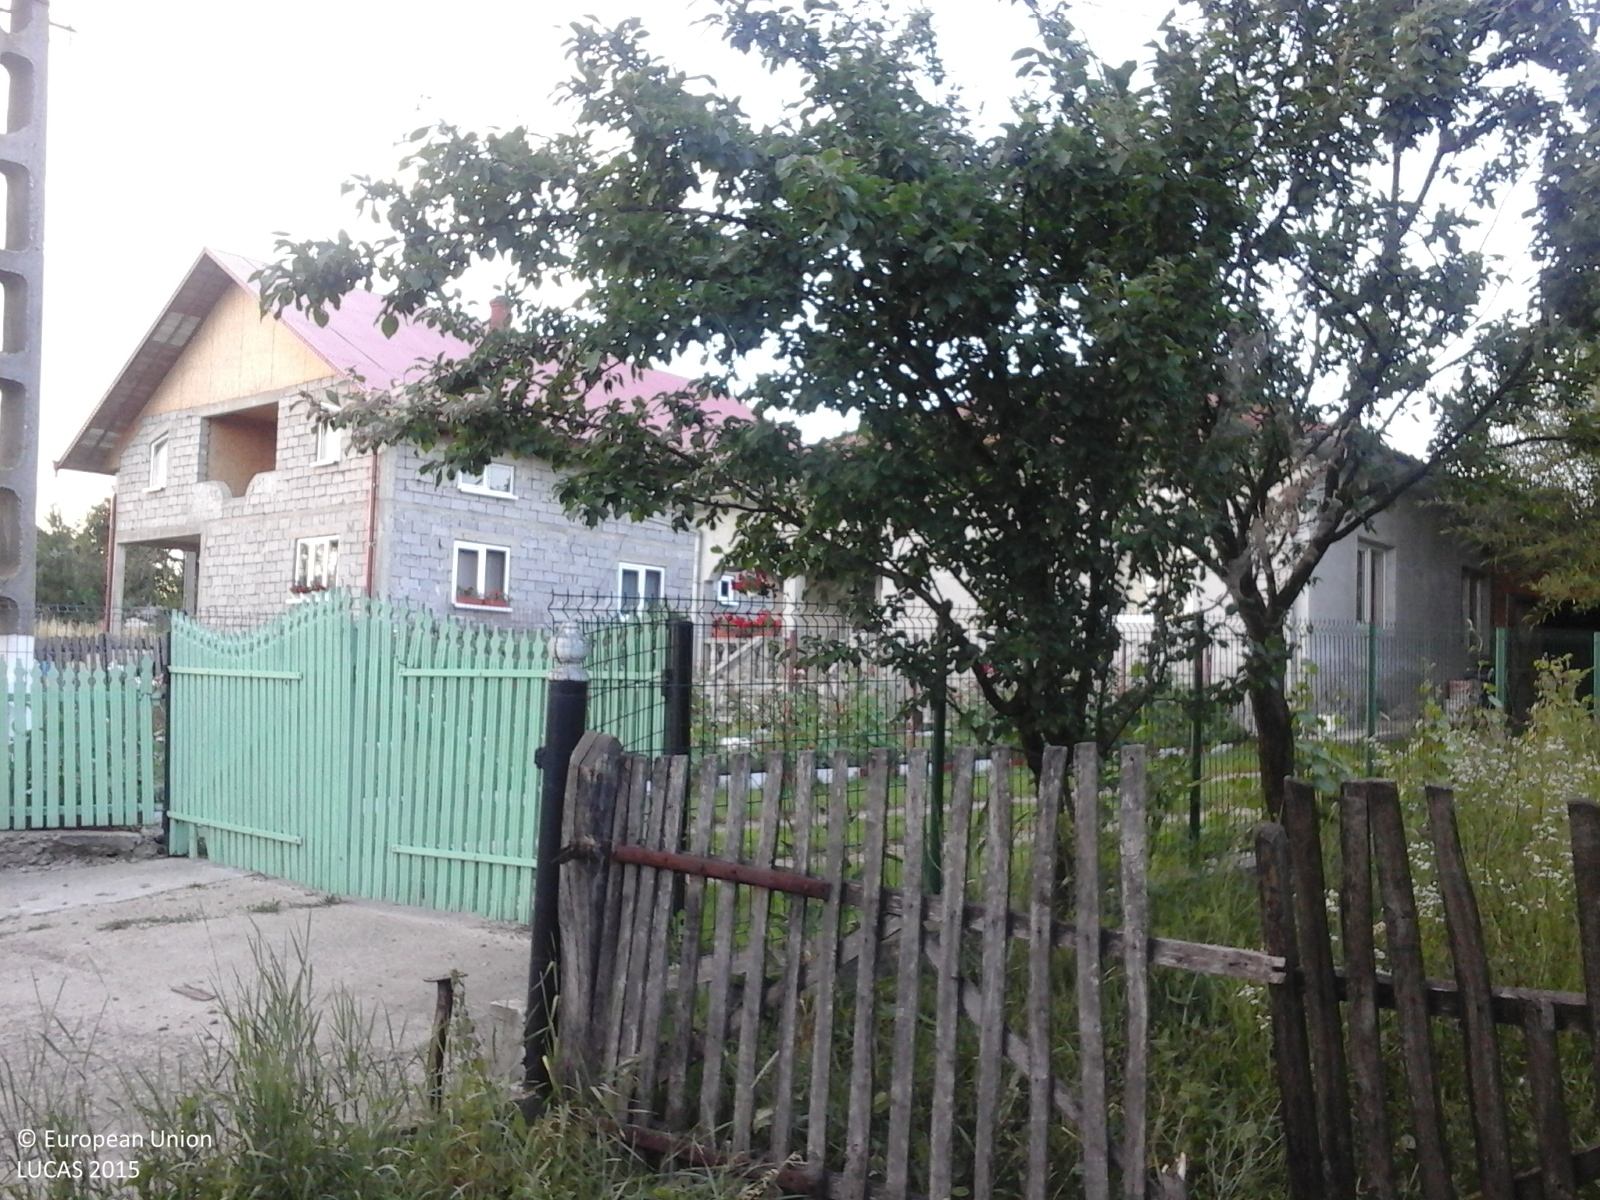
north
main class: Grassland
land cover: Grassland without tree/shrub cover
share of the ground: > 75 %
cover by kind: herbaceous plants 100 %
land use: Agriculture (excluding fallow land and kitchen gardens)
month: June
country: RO
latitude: 48.2015
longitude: 26.6054
